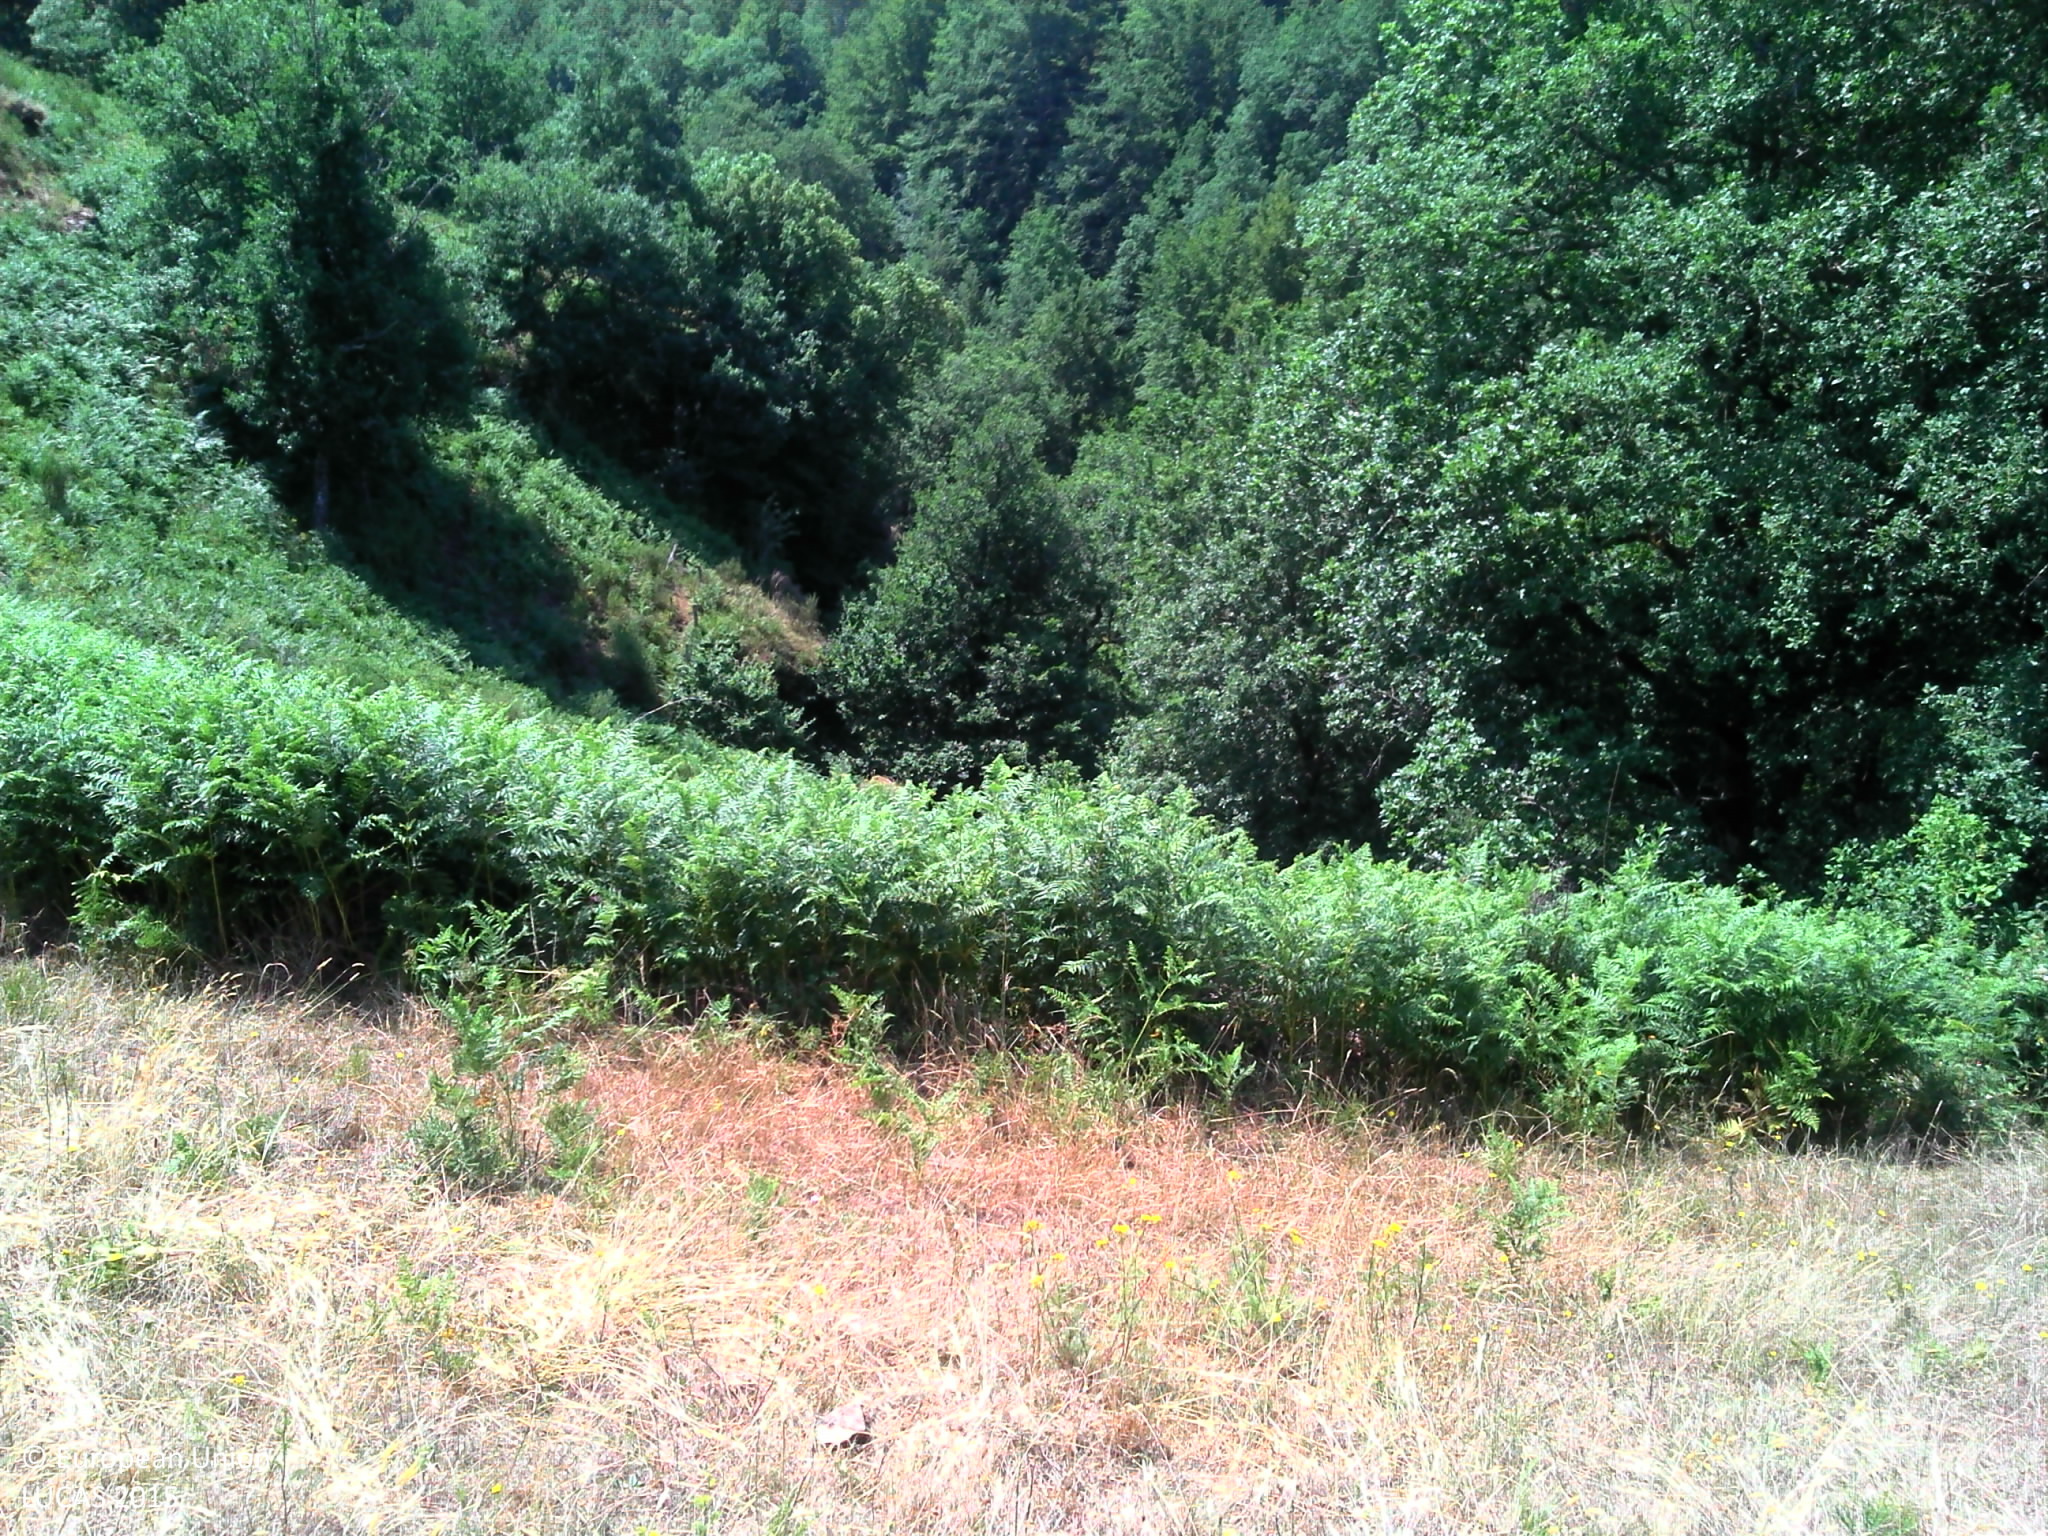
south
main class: Grassland
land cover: Grassland without tree/shrub cover
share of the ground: > 75 %
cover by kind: herbaceous plants 100 %
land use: Agriculture (excluding fallow land and kitchen gardens)
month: July
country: FR
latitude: 44.8494
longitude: 2.9042
